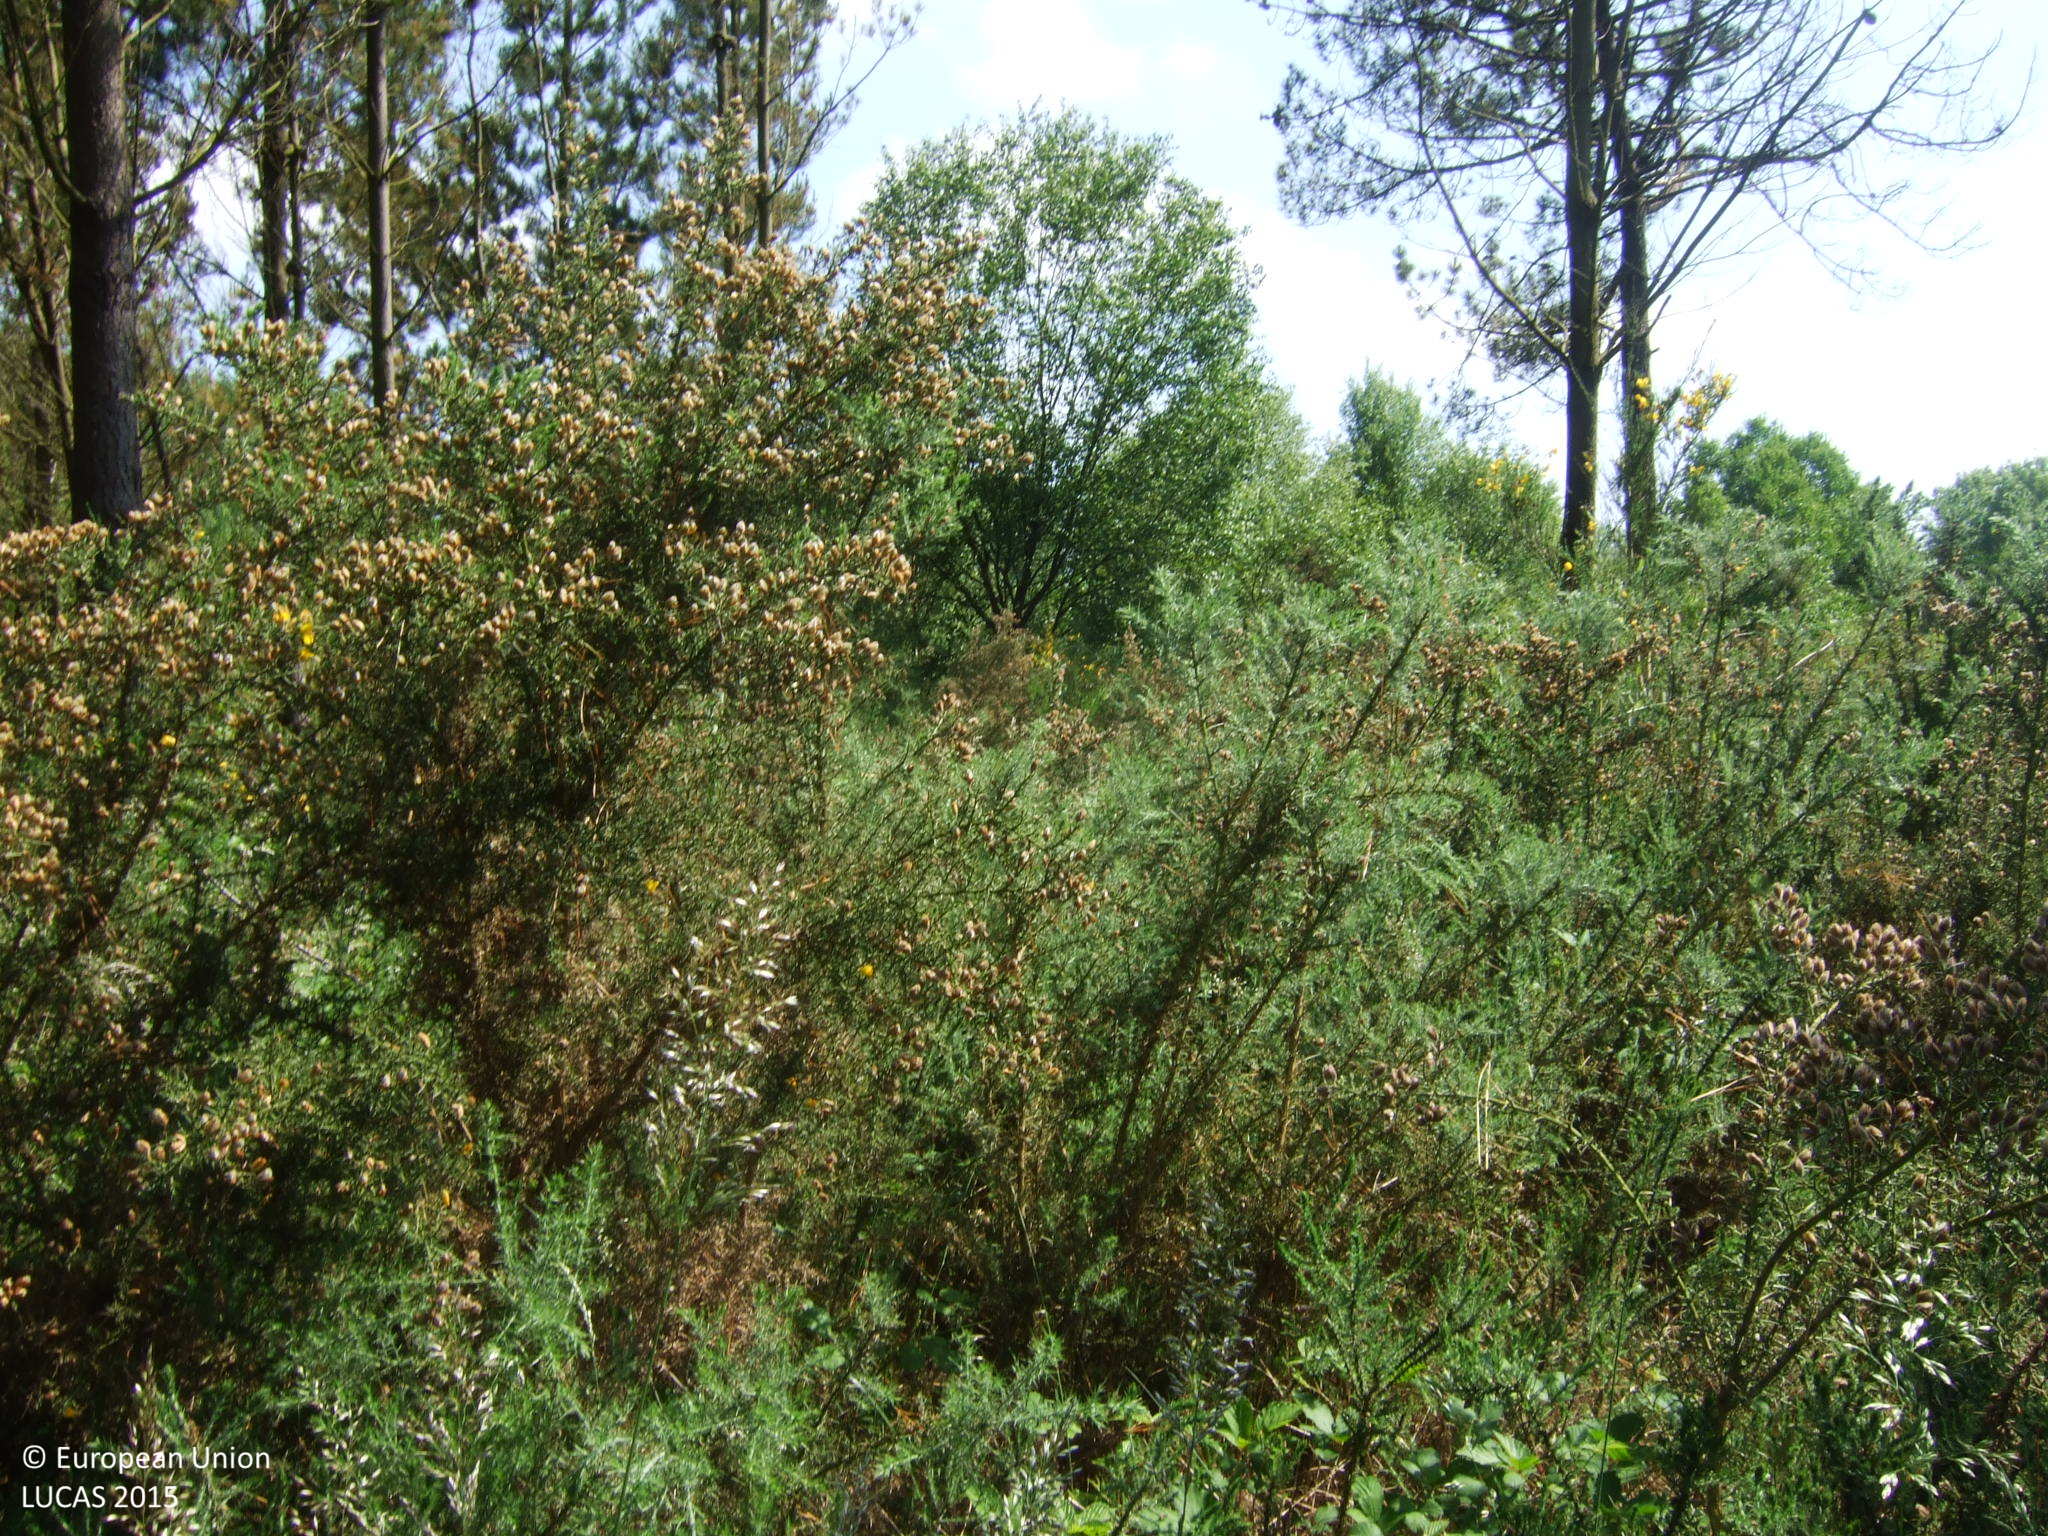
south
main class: Woodland
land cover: Pine dominated coniferous woodland
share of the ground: 25 - 50 %
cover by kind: shrubs 60 %, coniferous forest trees 40 %
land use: Forestry
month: June
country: ES
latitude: 43.2657
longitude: -7.4358
